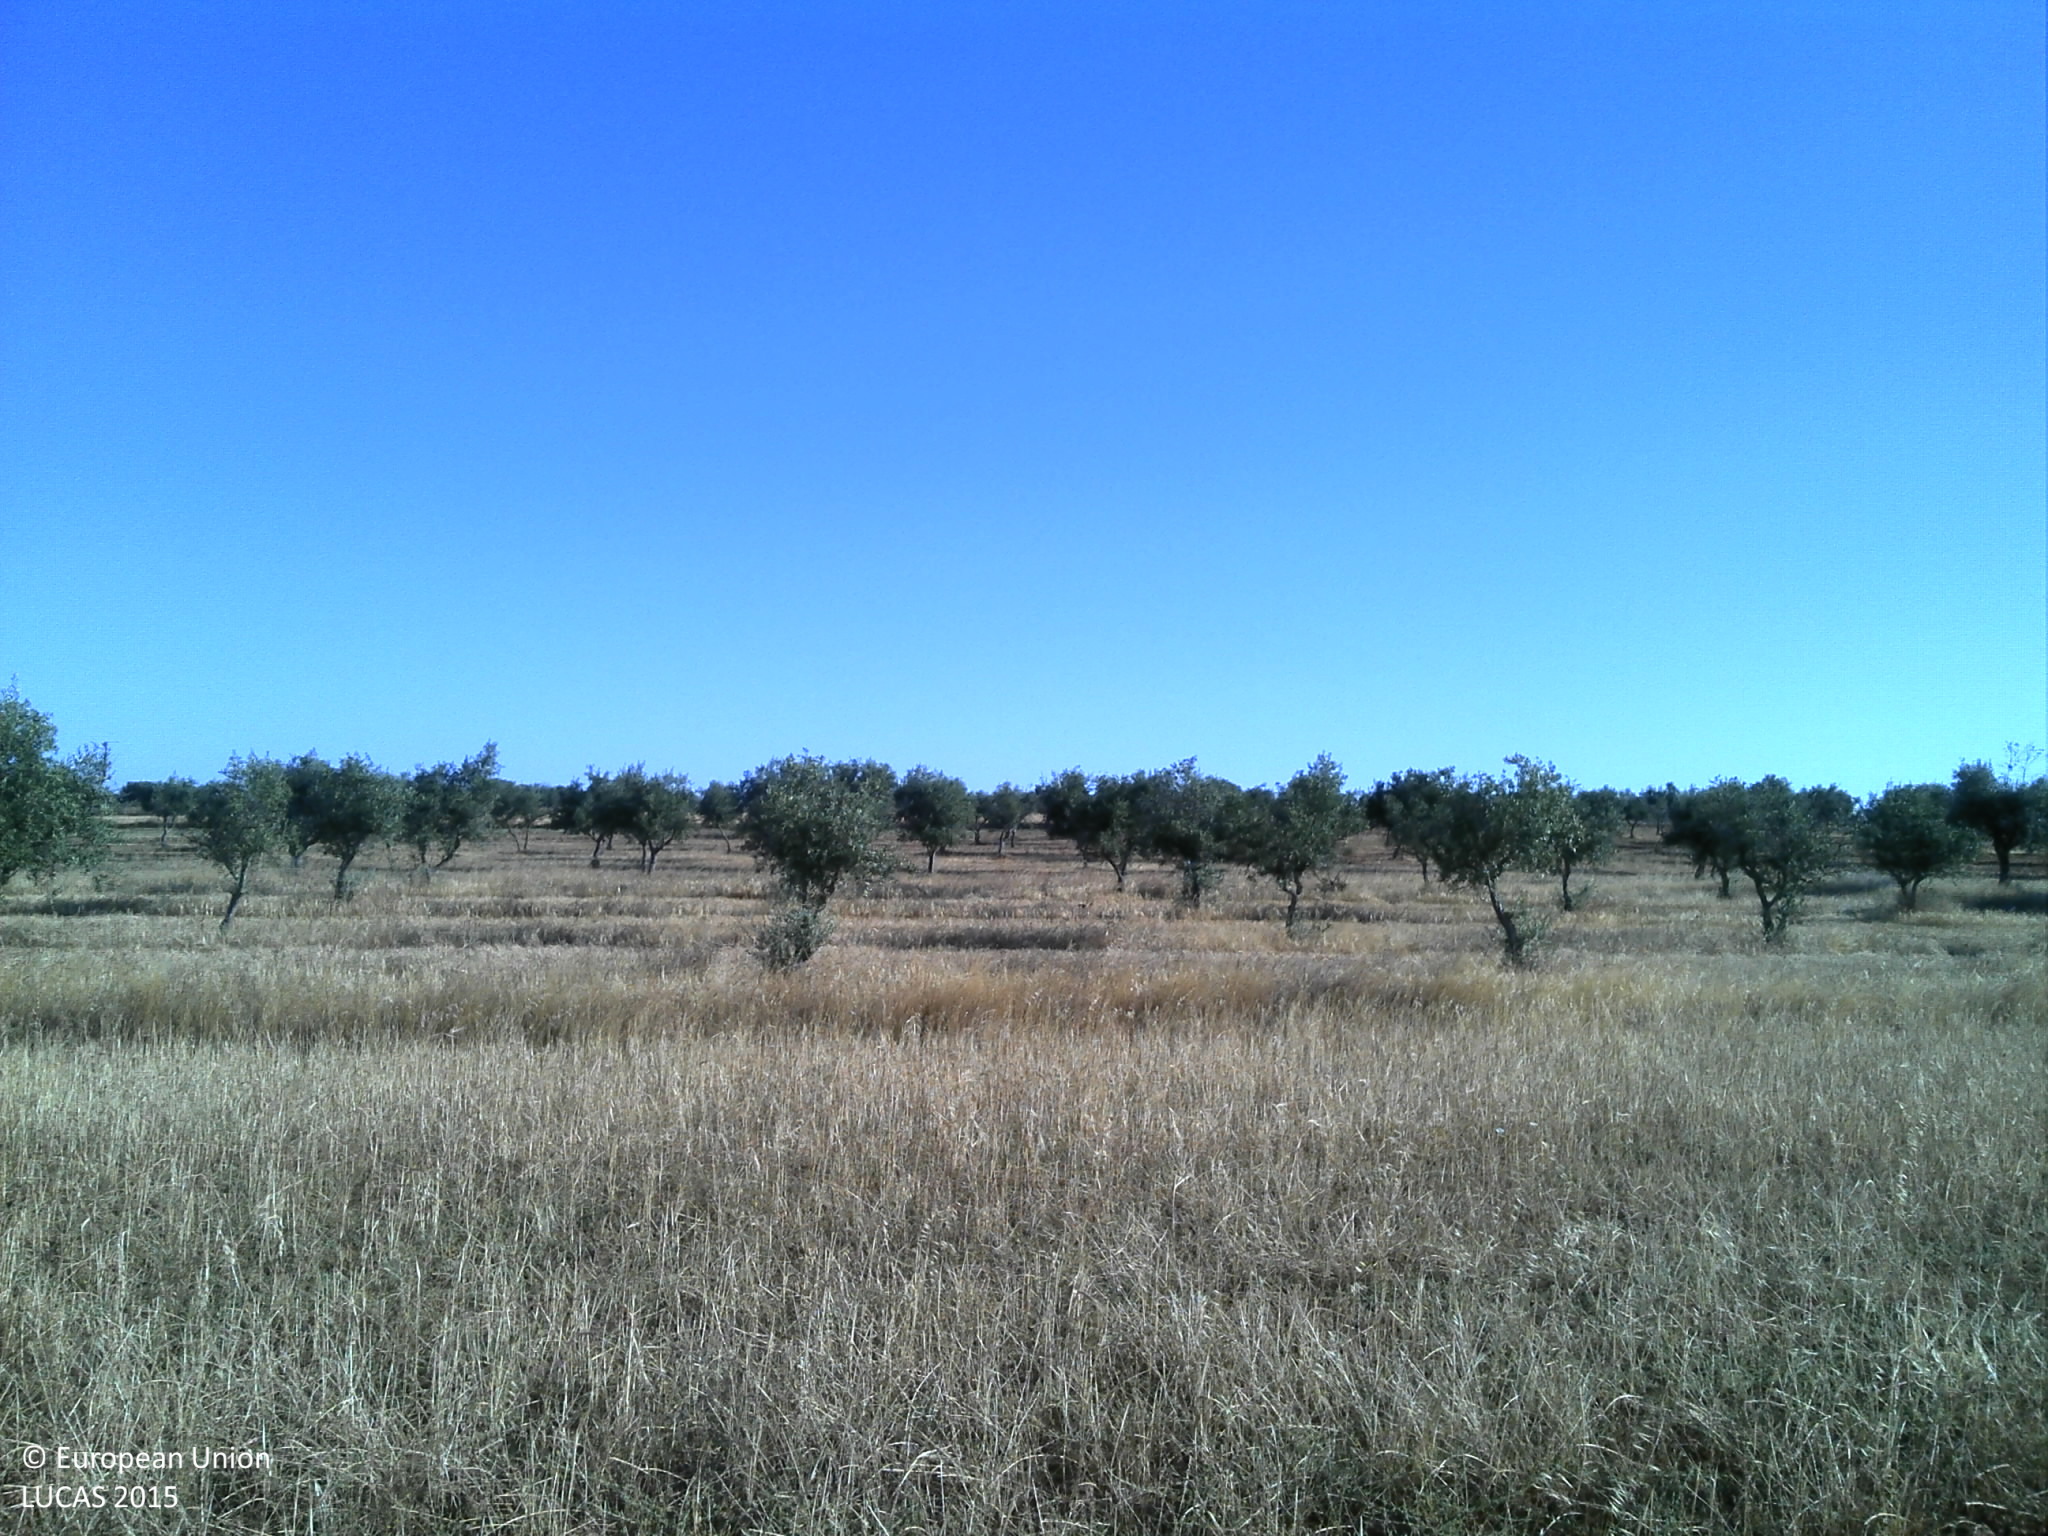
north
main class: Cropland
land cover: Triticale
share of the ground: 10 - 25 %
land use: Agriculture (excluding fallow land and kitchen gardens)
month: July
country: PT
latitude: 38.9281
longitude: -7.5596
